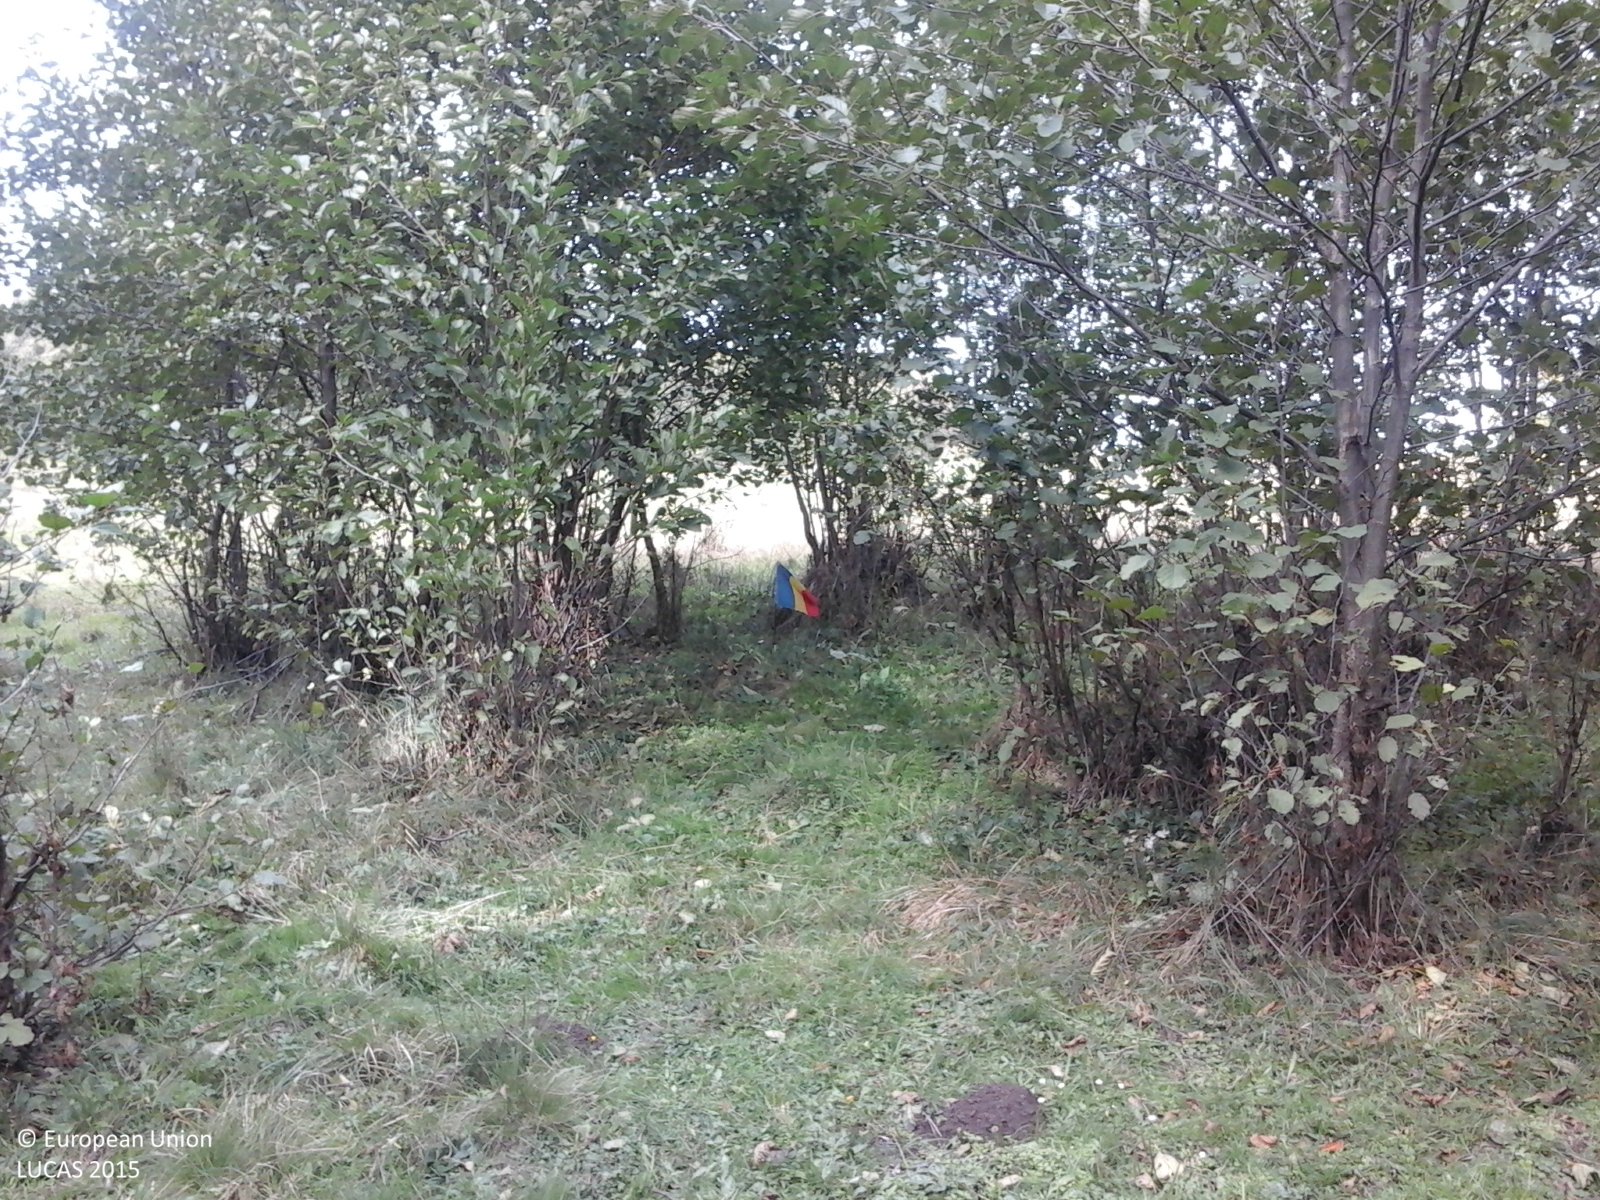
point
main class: Woodland
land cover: Broadleaved woodland
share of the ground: > 75 %
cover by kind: broadleaved forest trees 100 %
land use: Forestry
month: October
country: RO
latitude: 46.3046
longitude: 25.1741
